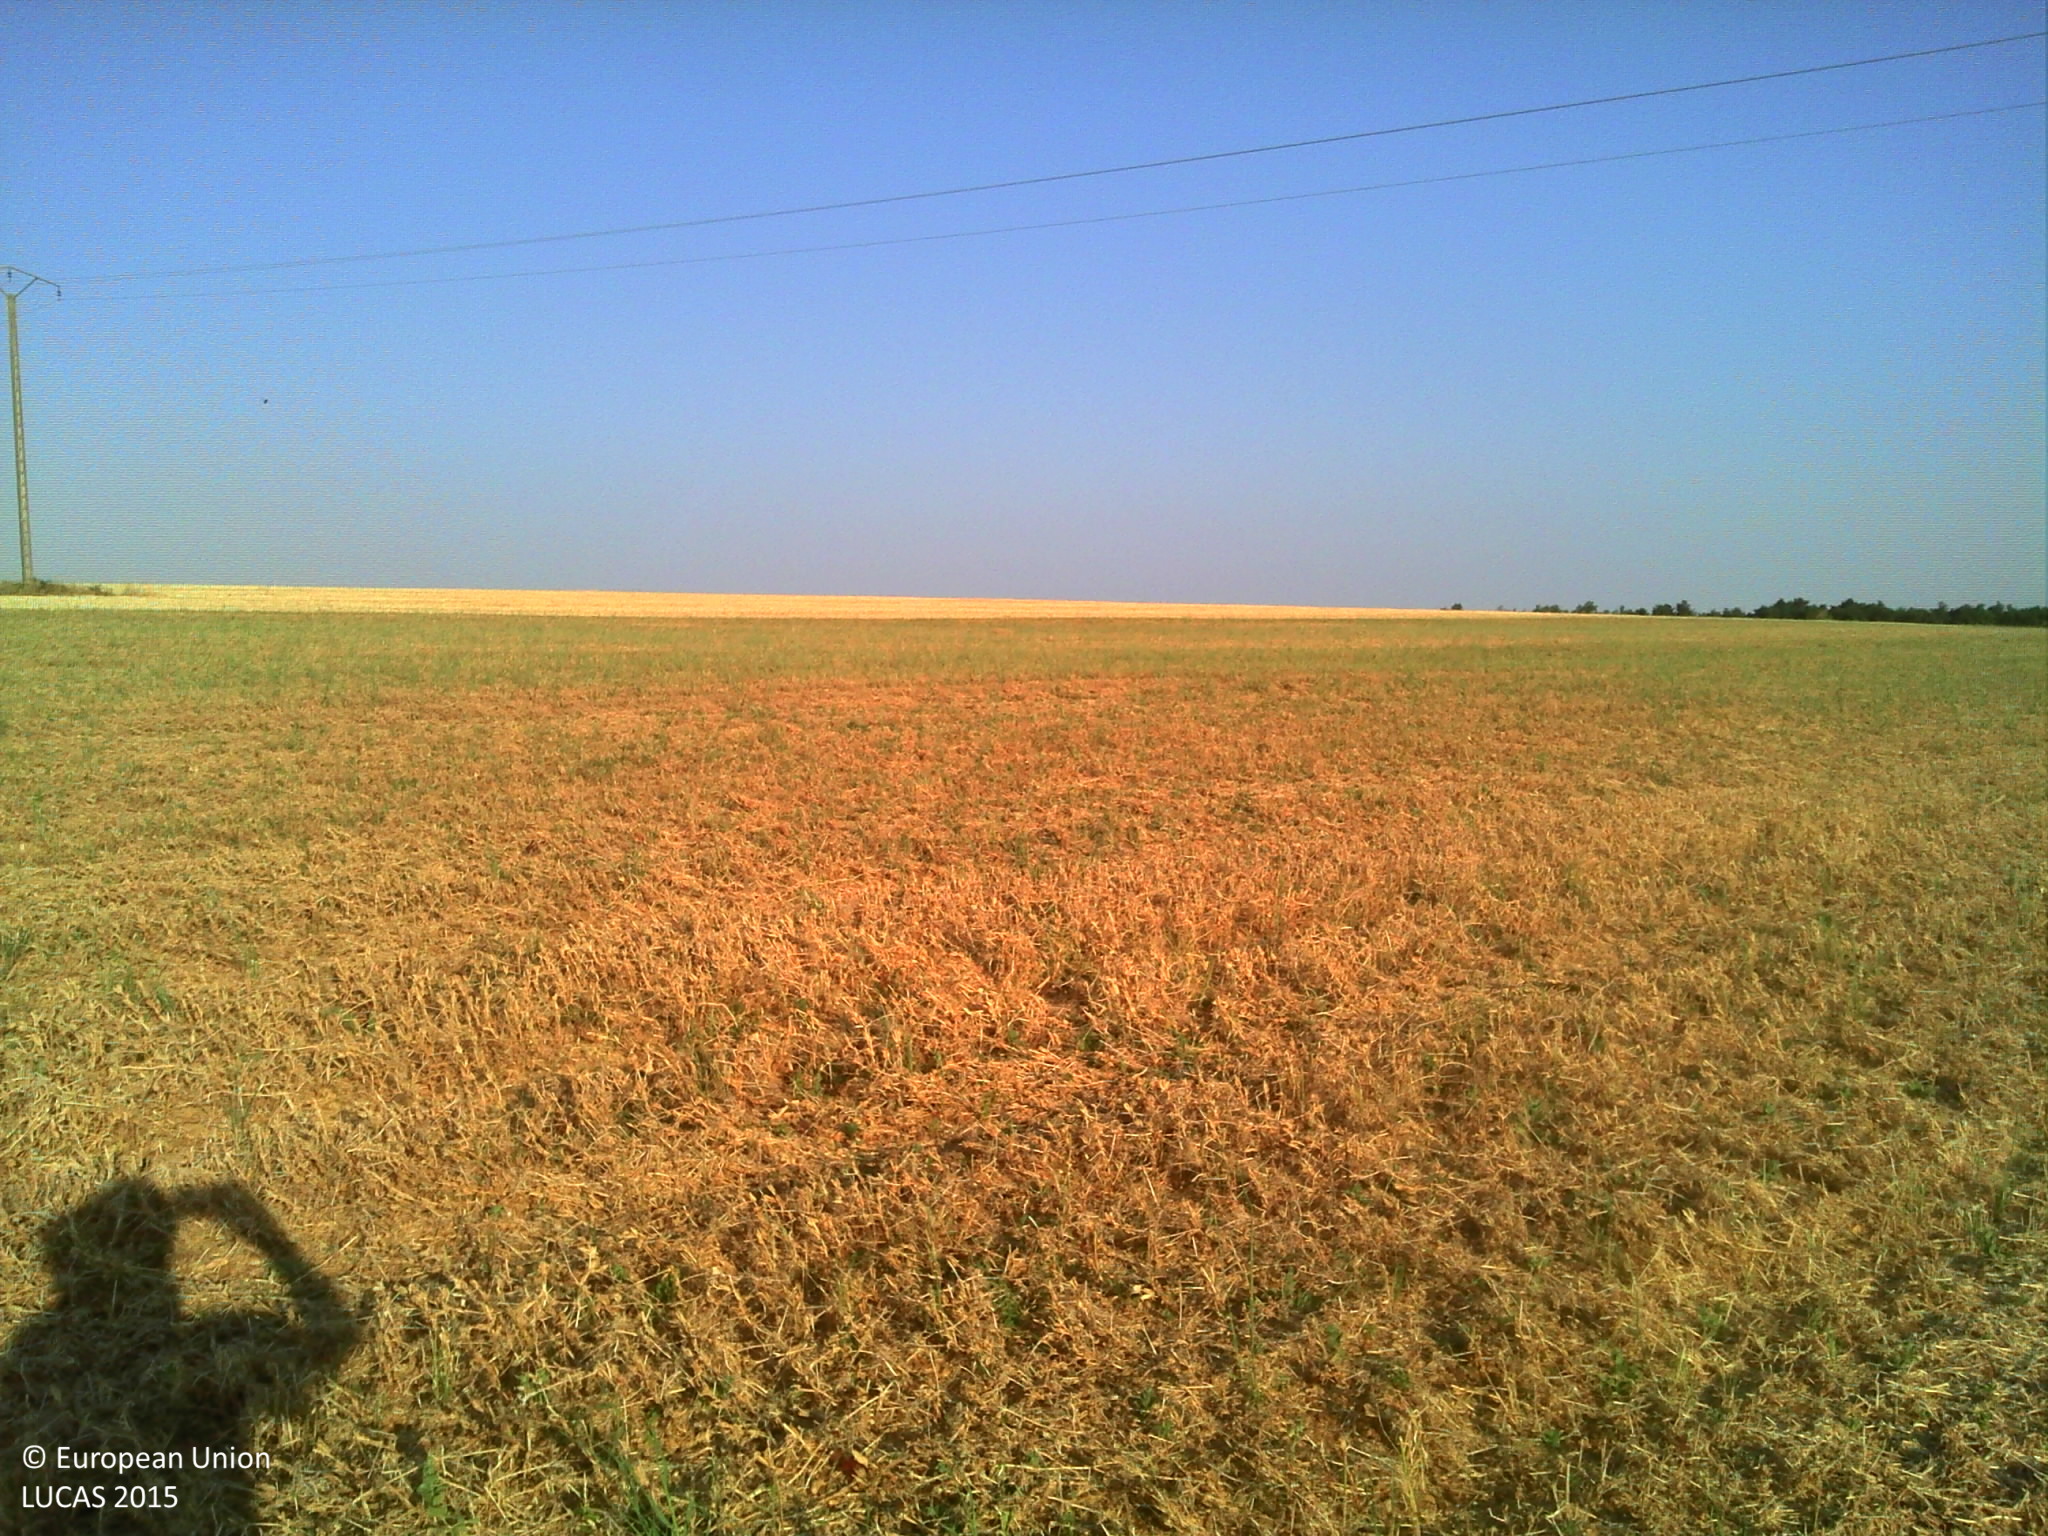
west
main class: Cropland
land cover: Dry pulses
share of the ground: > 75 %
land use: Agriculture (excluding fallow land and kitchen gardens)
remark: Harvested field
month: July
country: FR
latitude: 47.7054
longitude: 3.4786
